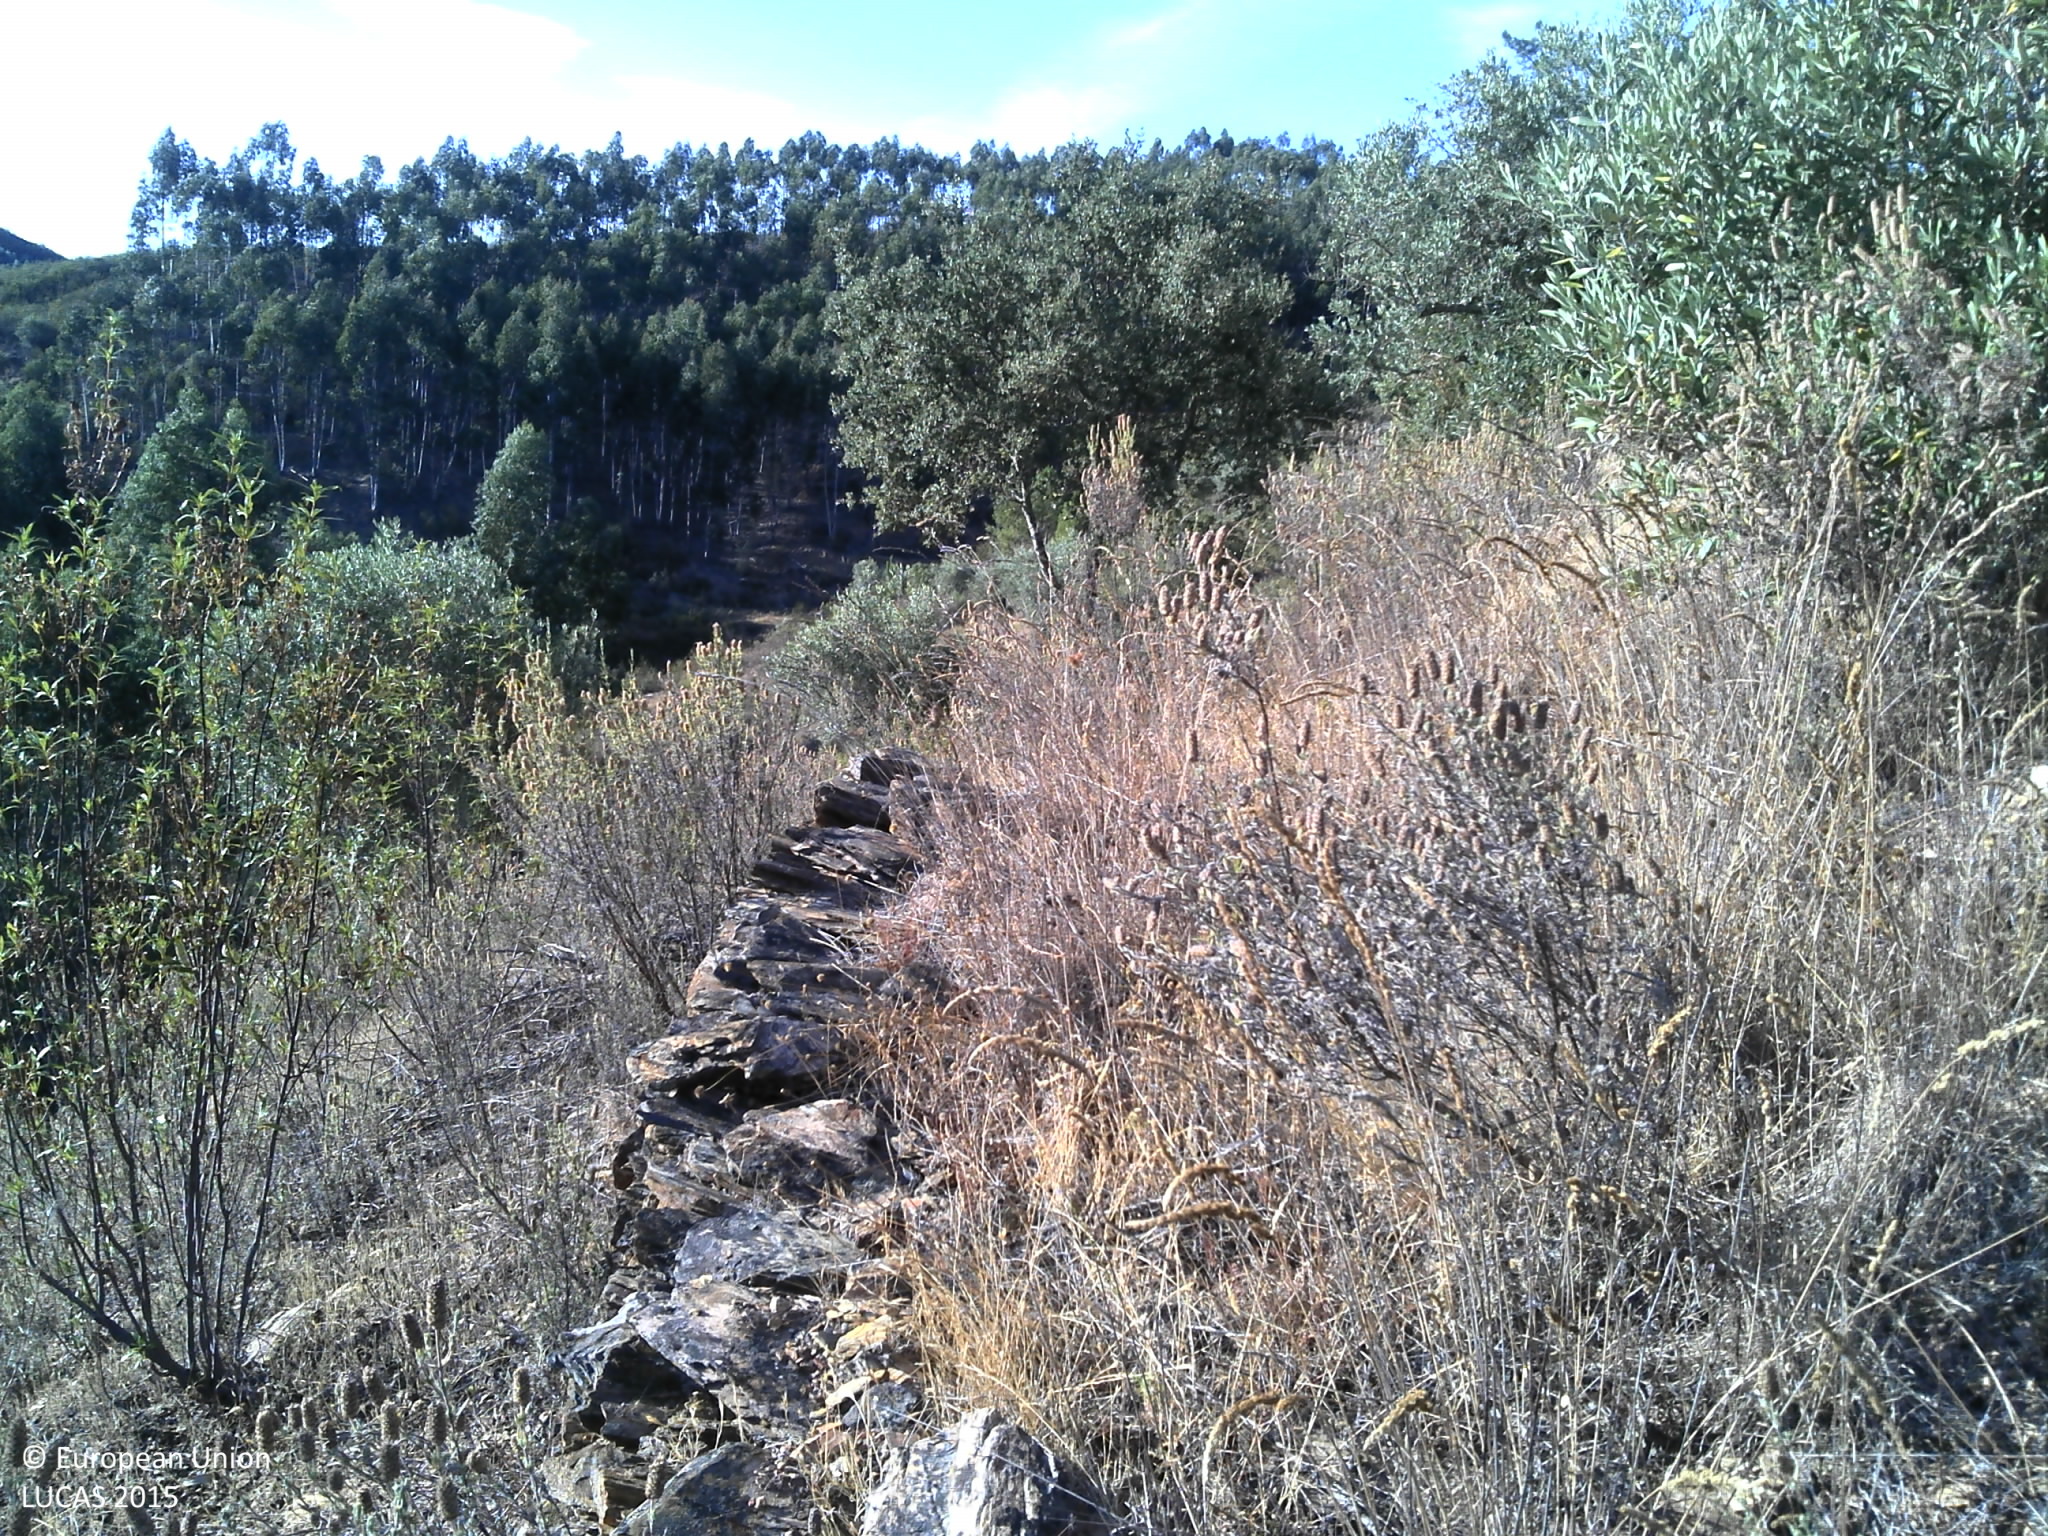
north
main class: Cropland
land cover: Olive groves
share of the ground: < 10 %
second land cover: Shrubland without tree cover
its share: > 75 %
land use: Abandoned areas
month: July
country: PT
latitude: 39.6570
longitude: -7.7124
